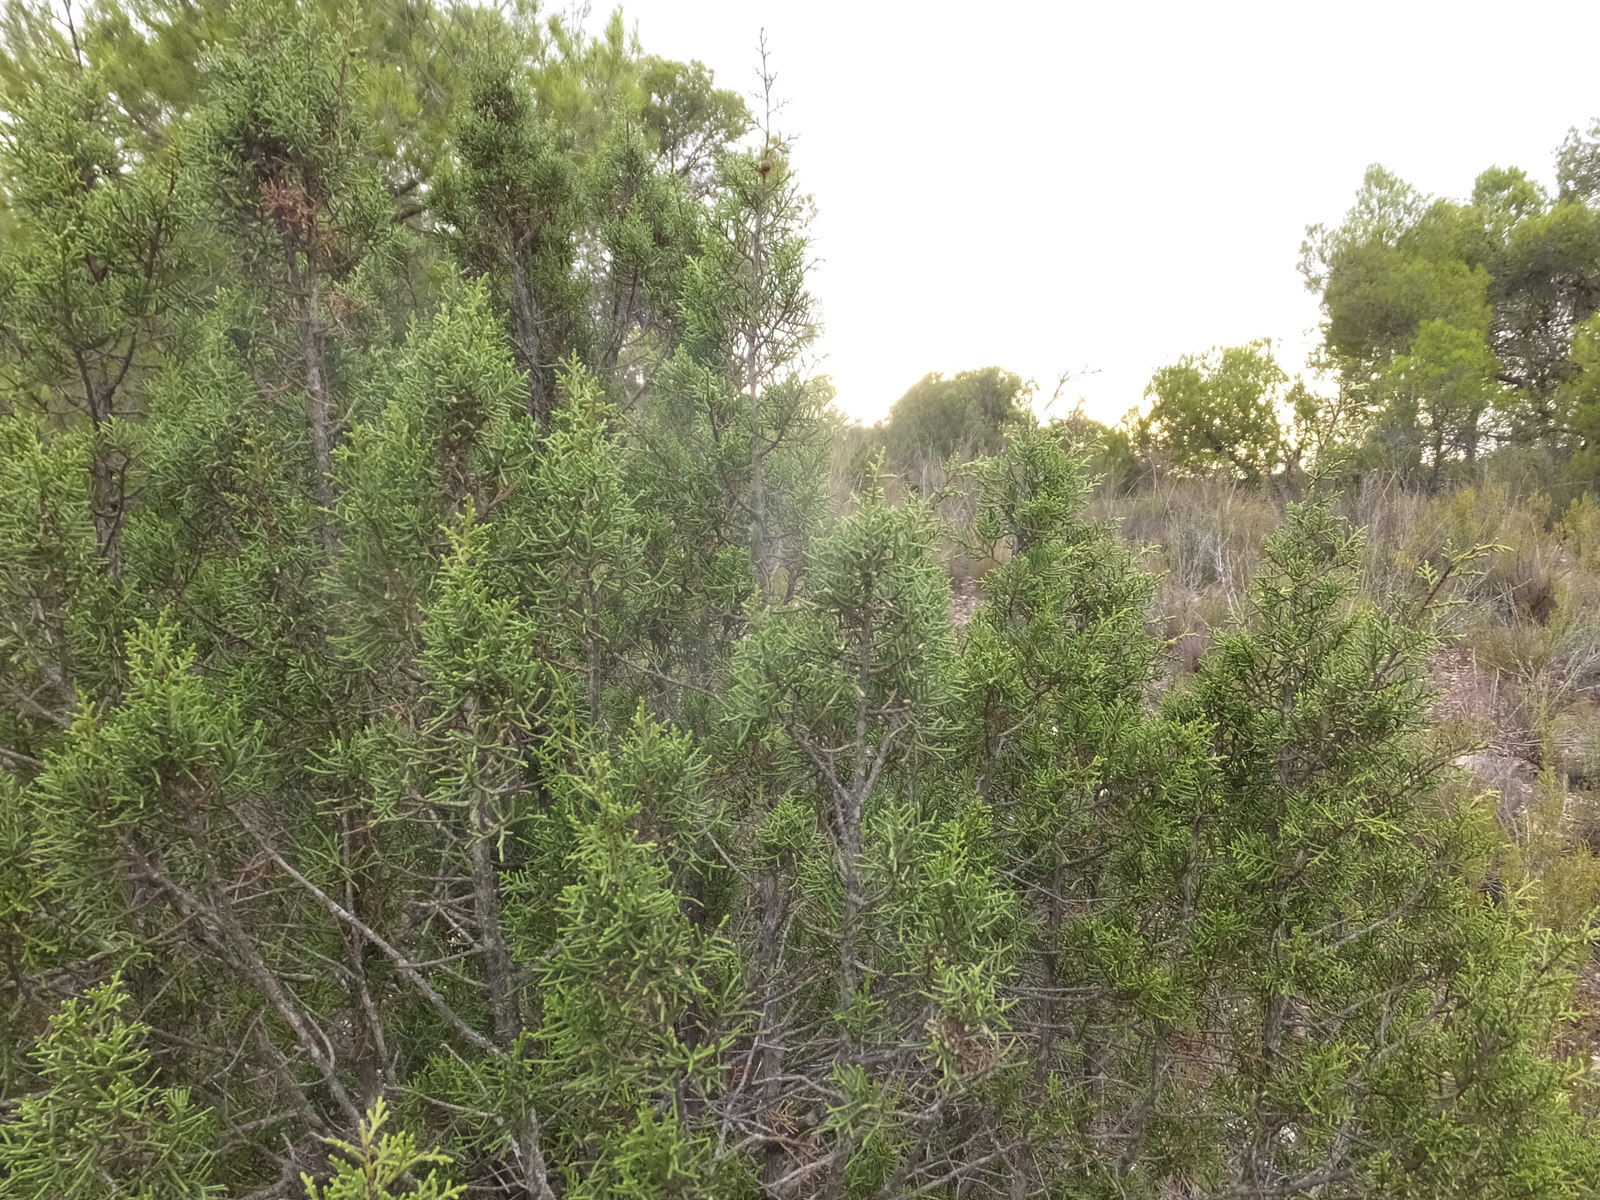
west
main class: Woodland
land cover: Pine dominated mixed woodland
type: coniferous forest of the mediterranean region
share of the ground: 50 - 75 %
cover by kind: coniferous forest trees 60 %, broadleaved forest trees 20 %, shrubs 20 %
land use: Forestry
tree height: > 5 m
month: August
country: ES
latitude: 41.1800
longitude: 0.2261
